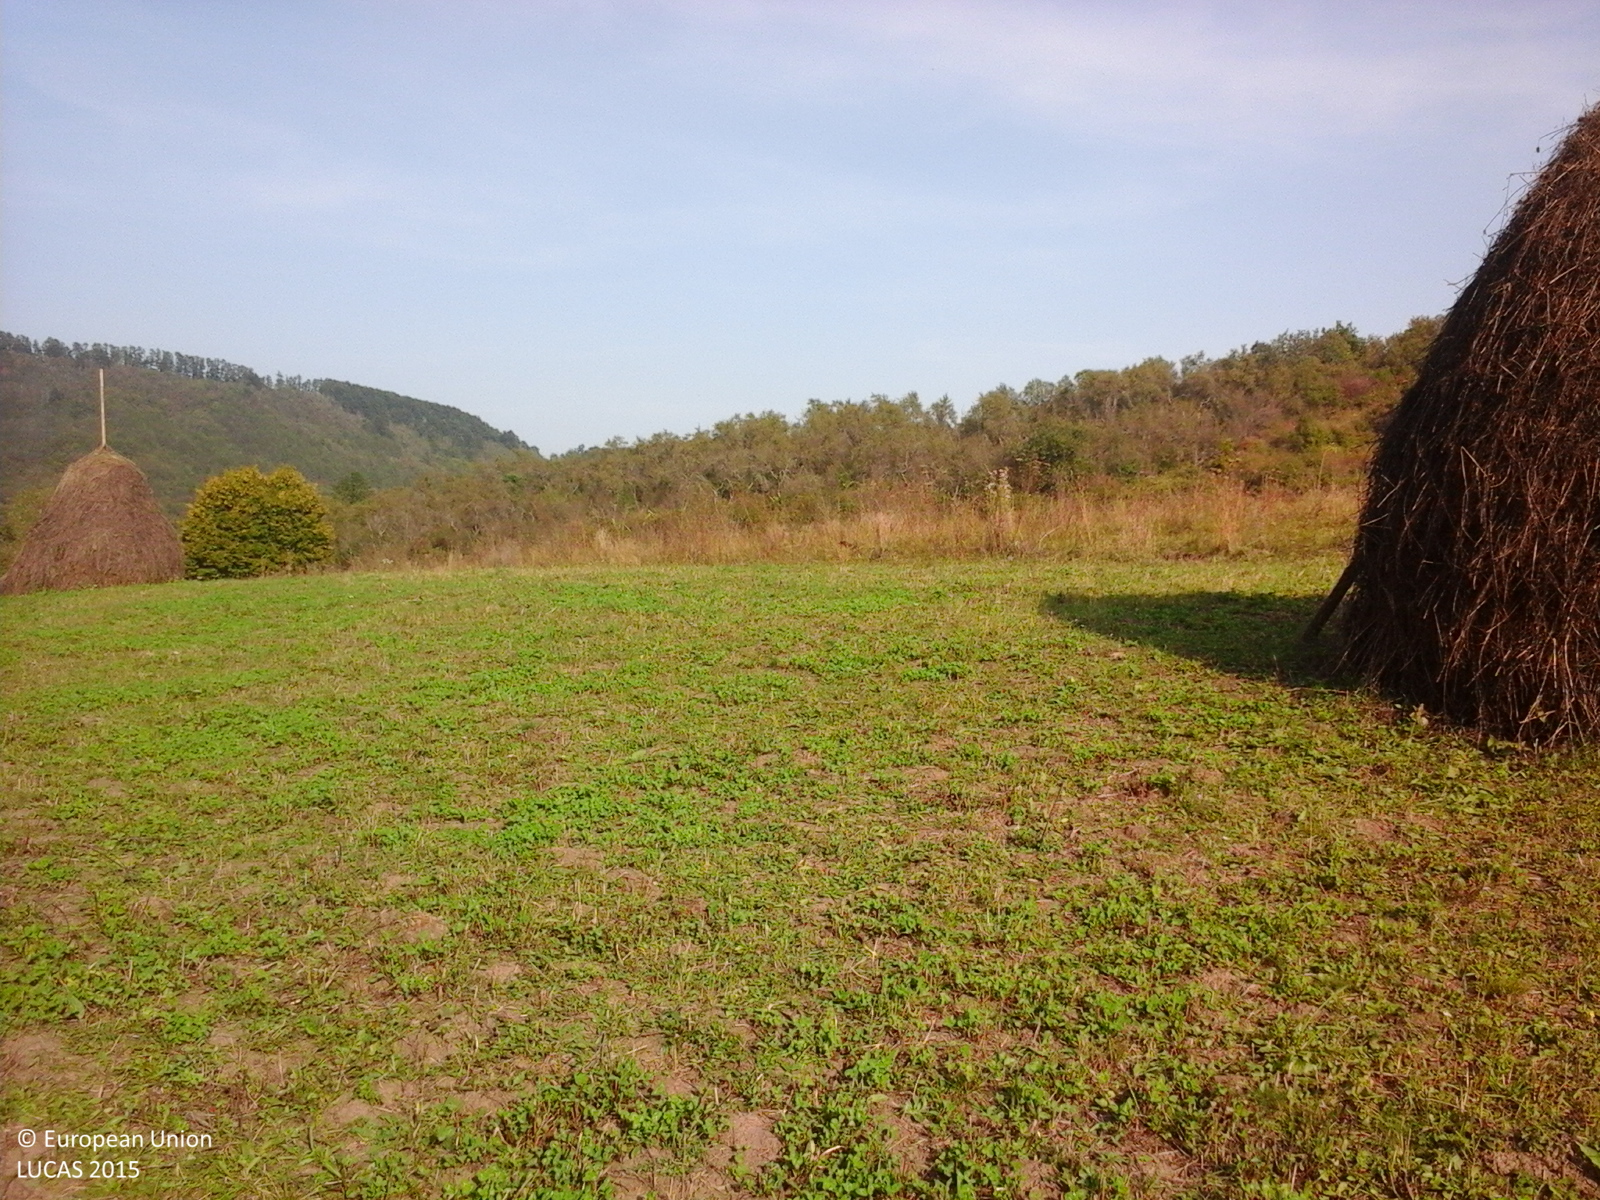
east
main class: Shrubland
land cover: Shrubland without tree cover
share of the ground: > 75 %
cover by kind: shrubs 100 %
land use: Fallow land
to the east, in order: Shrubland without tree cover; Grassland without tree/shrub cover; Broadleaved woodland; Other fruit trees and berries; Grassland without tree/shrub cover
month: September
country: RO
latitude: 47.0040
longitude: 23.3652
